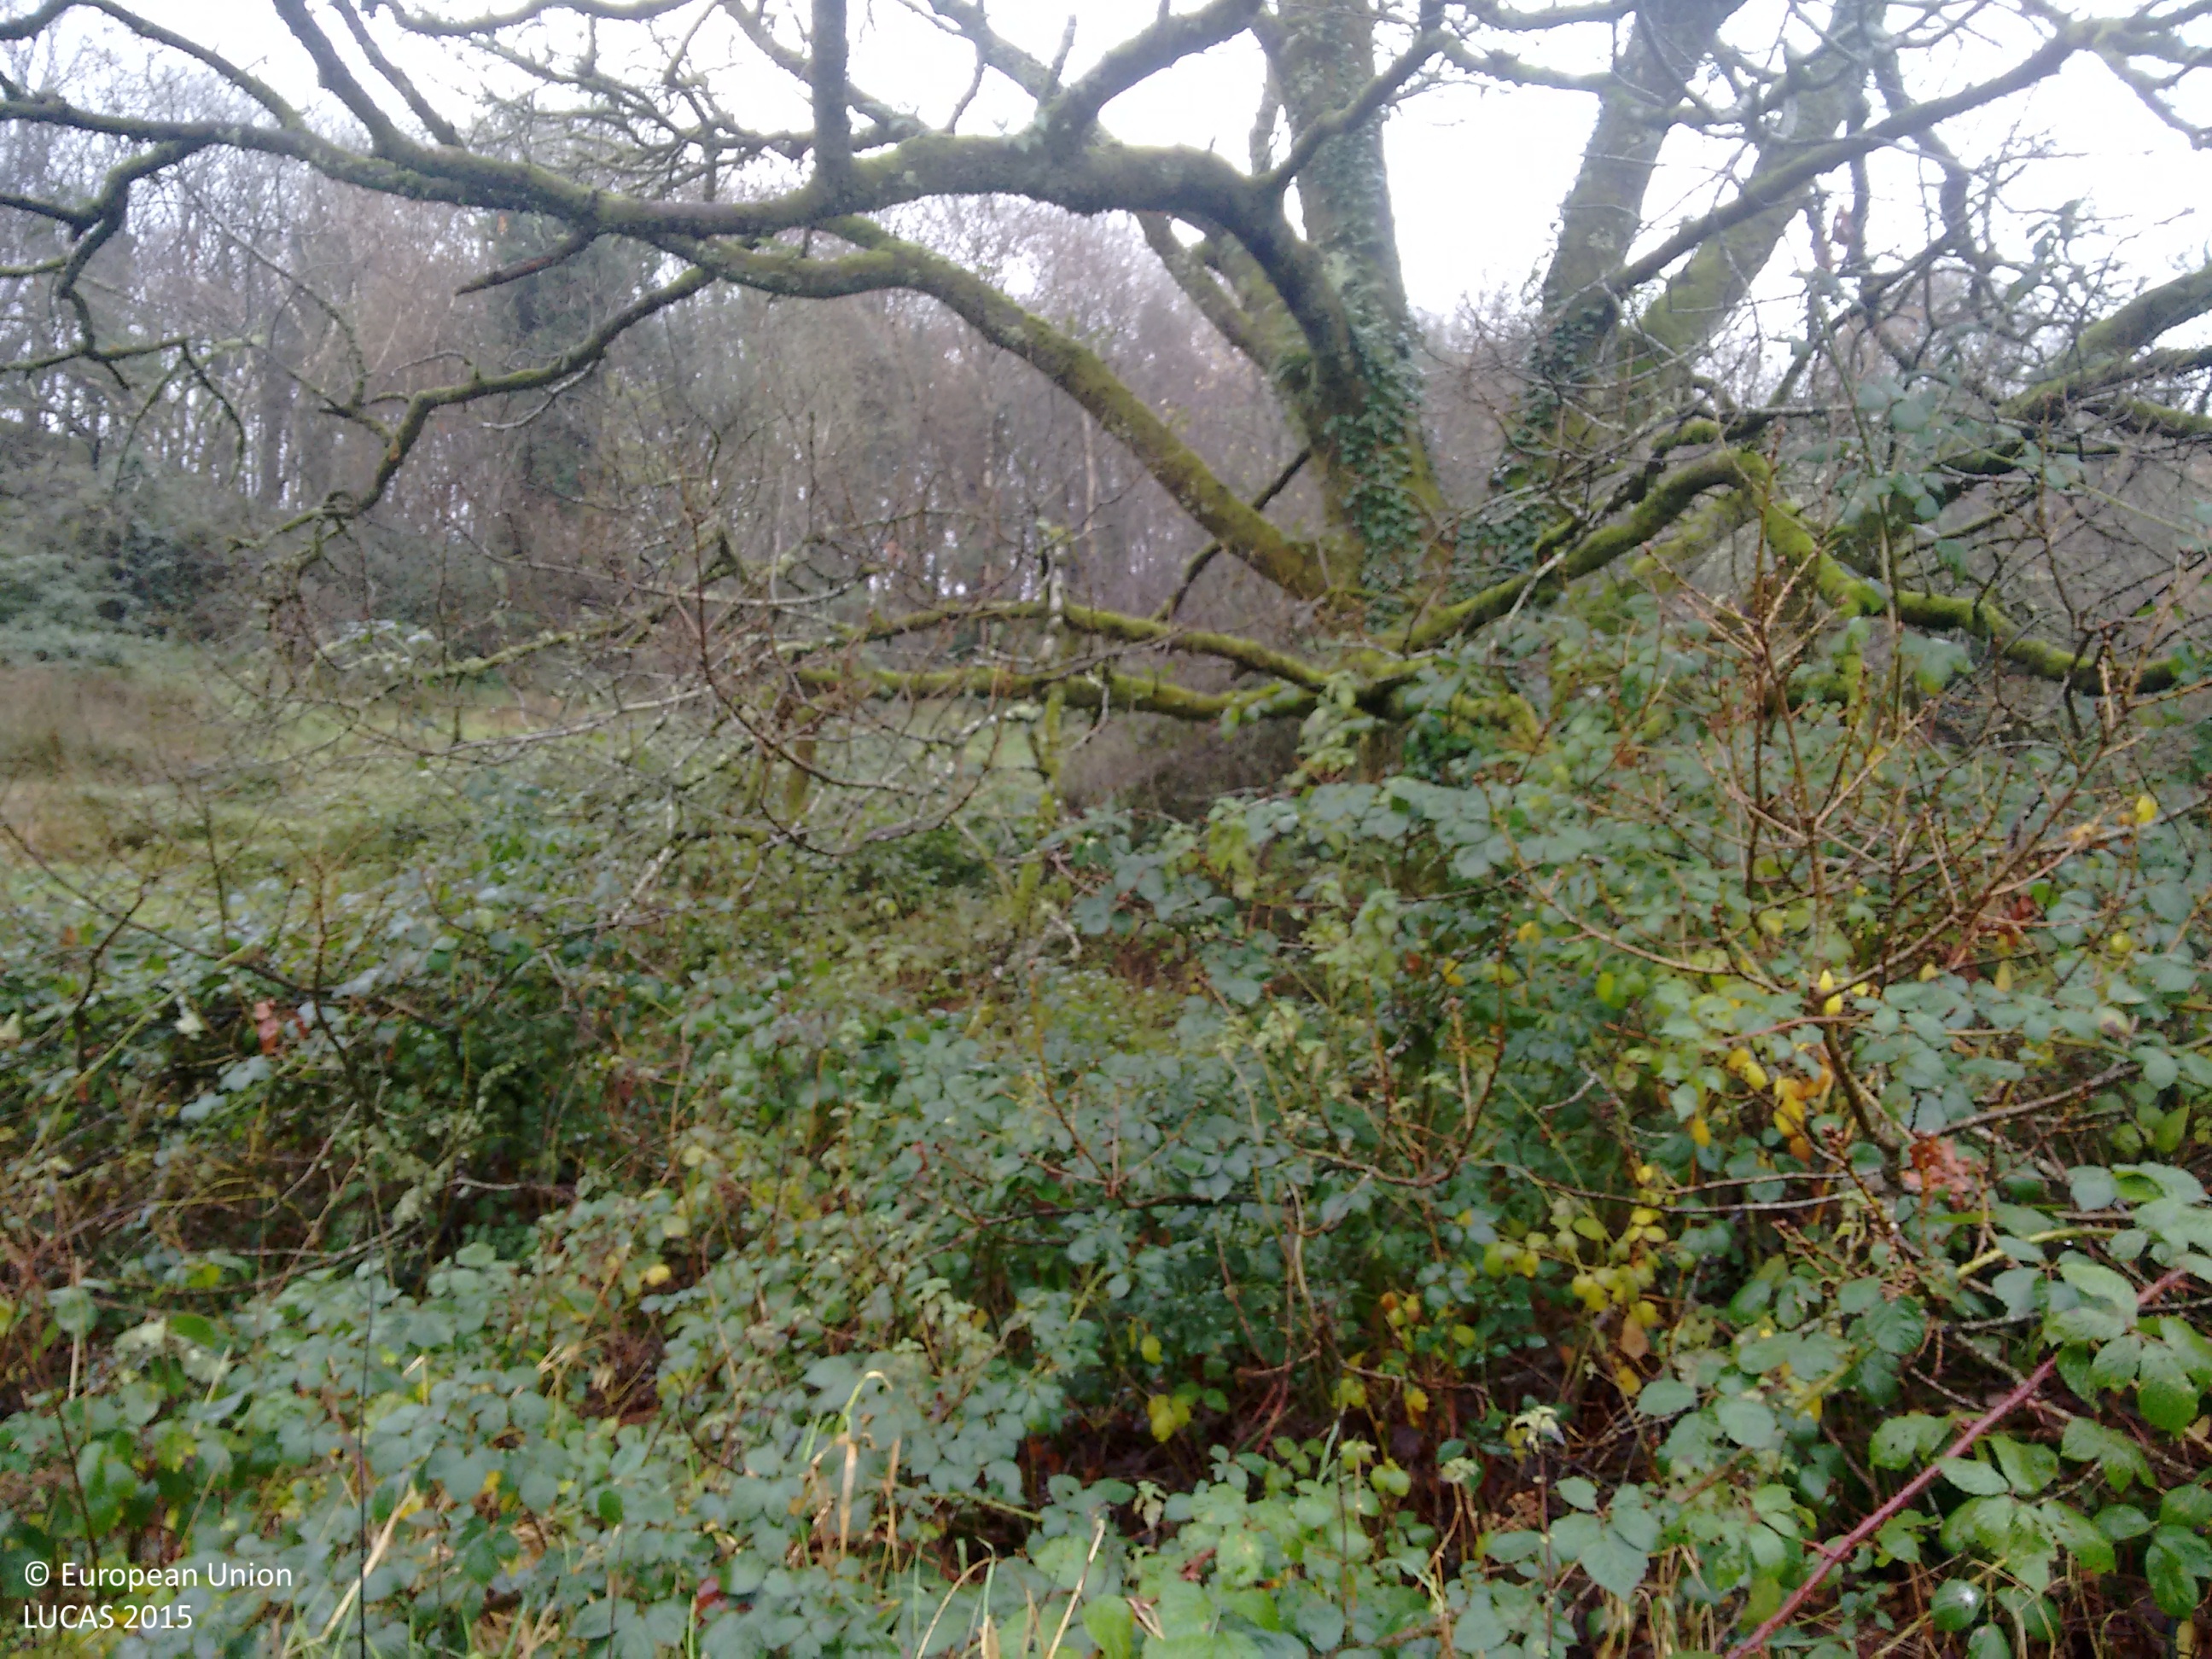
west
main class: Woodland
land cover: Broadleaved woodland
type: exotic forest
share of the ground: > 75 %
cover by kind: broadleaved forest trees 50 %, shrubs 40 %, herbaceous plants 10 %
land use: Agriculture (excluding fallow land and kitchen gardens)
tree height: > 5 m
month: November
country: IE
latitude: 54.0513
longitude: -8.3479
